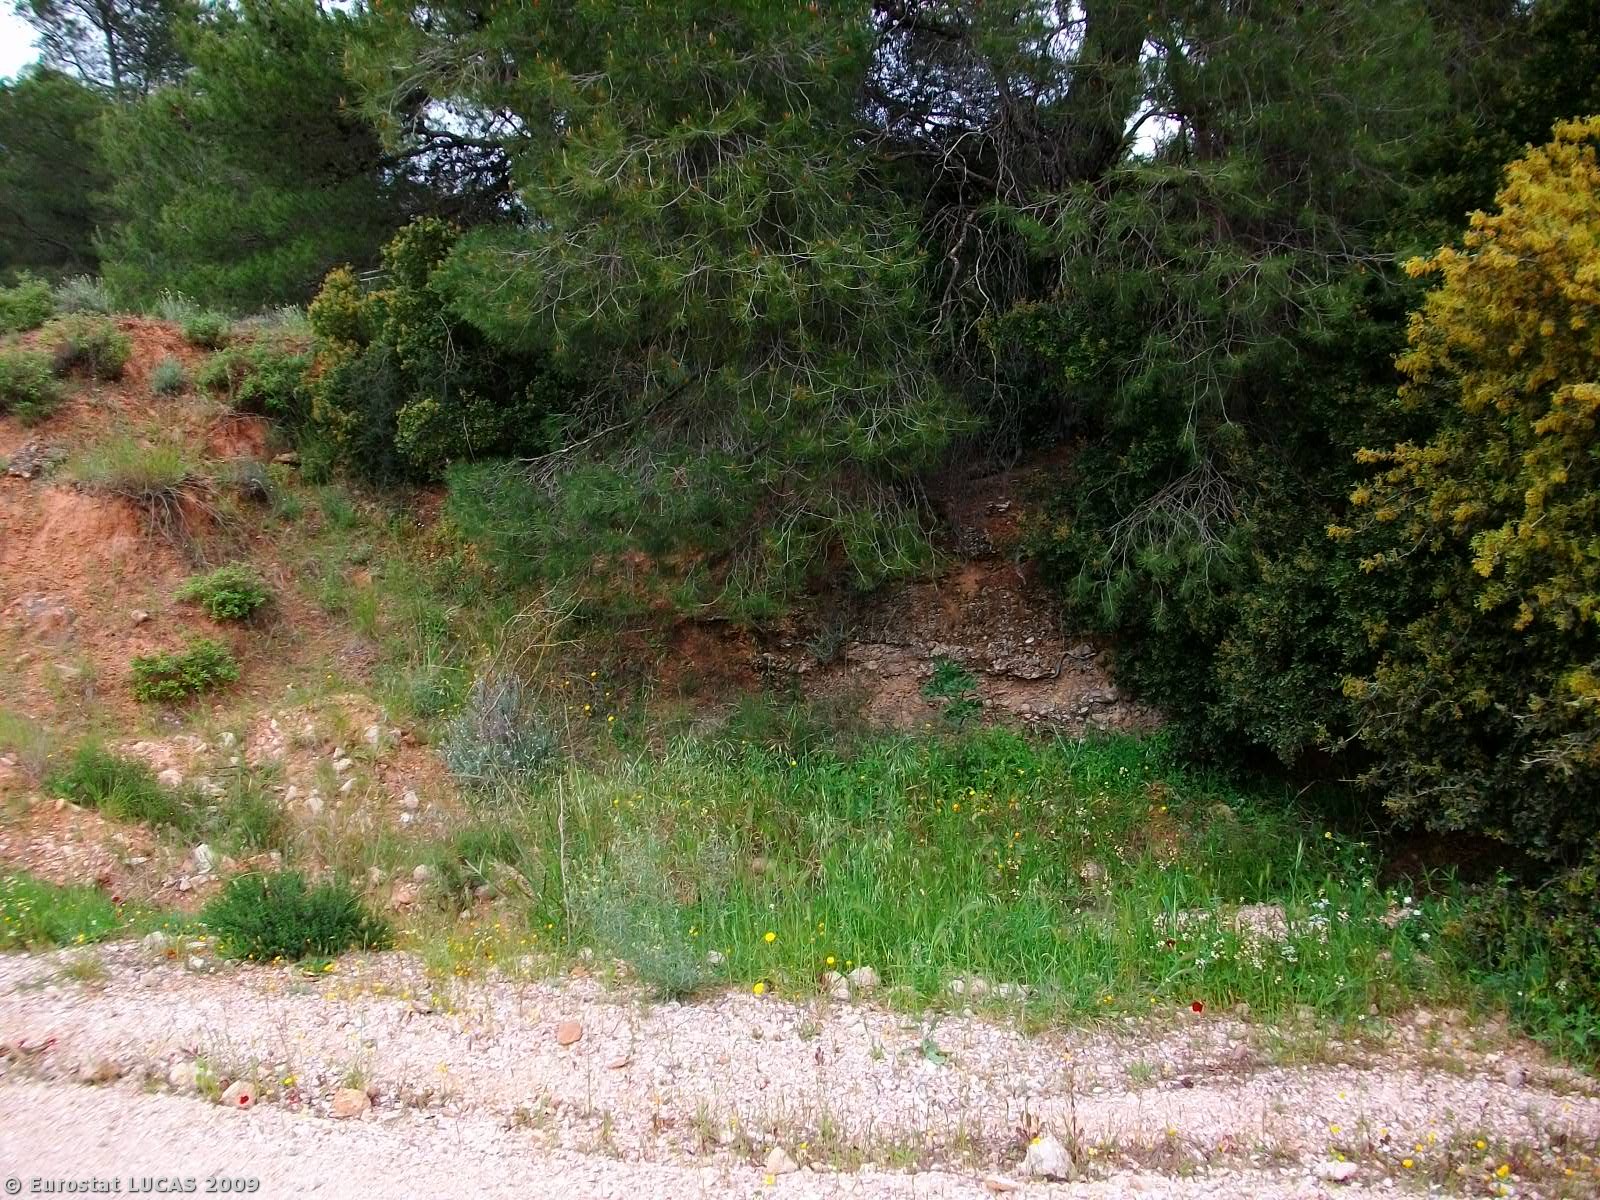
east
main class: Woodland
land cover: Mixed woodland
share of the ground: > 75 %
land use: Unused
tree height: < 5 m
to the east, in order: Mixed woodland; Grassland without tree/shrub cover; Paved roads, cycling and walking lanes; Coniferous woodland; Fences; Paved roads, cycling and walking lanes; Shrubland without tree cover; Fences; Coniferous woodland; Fences; Electric lines; Paved roads, cycling and walking lanes; Fences; Coniferous woodland; Fences; Artificial constructions in urban areas; Coniferous woodland
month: May
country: GR
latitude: 38.1139
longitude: 23.7954
